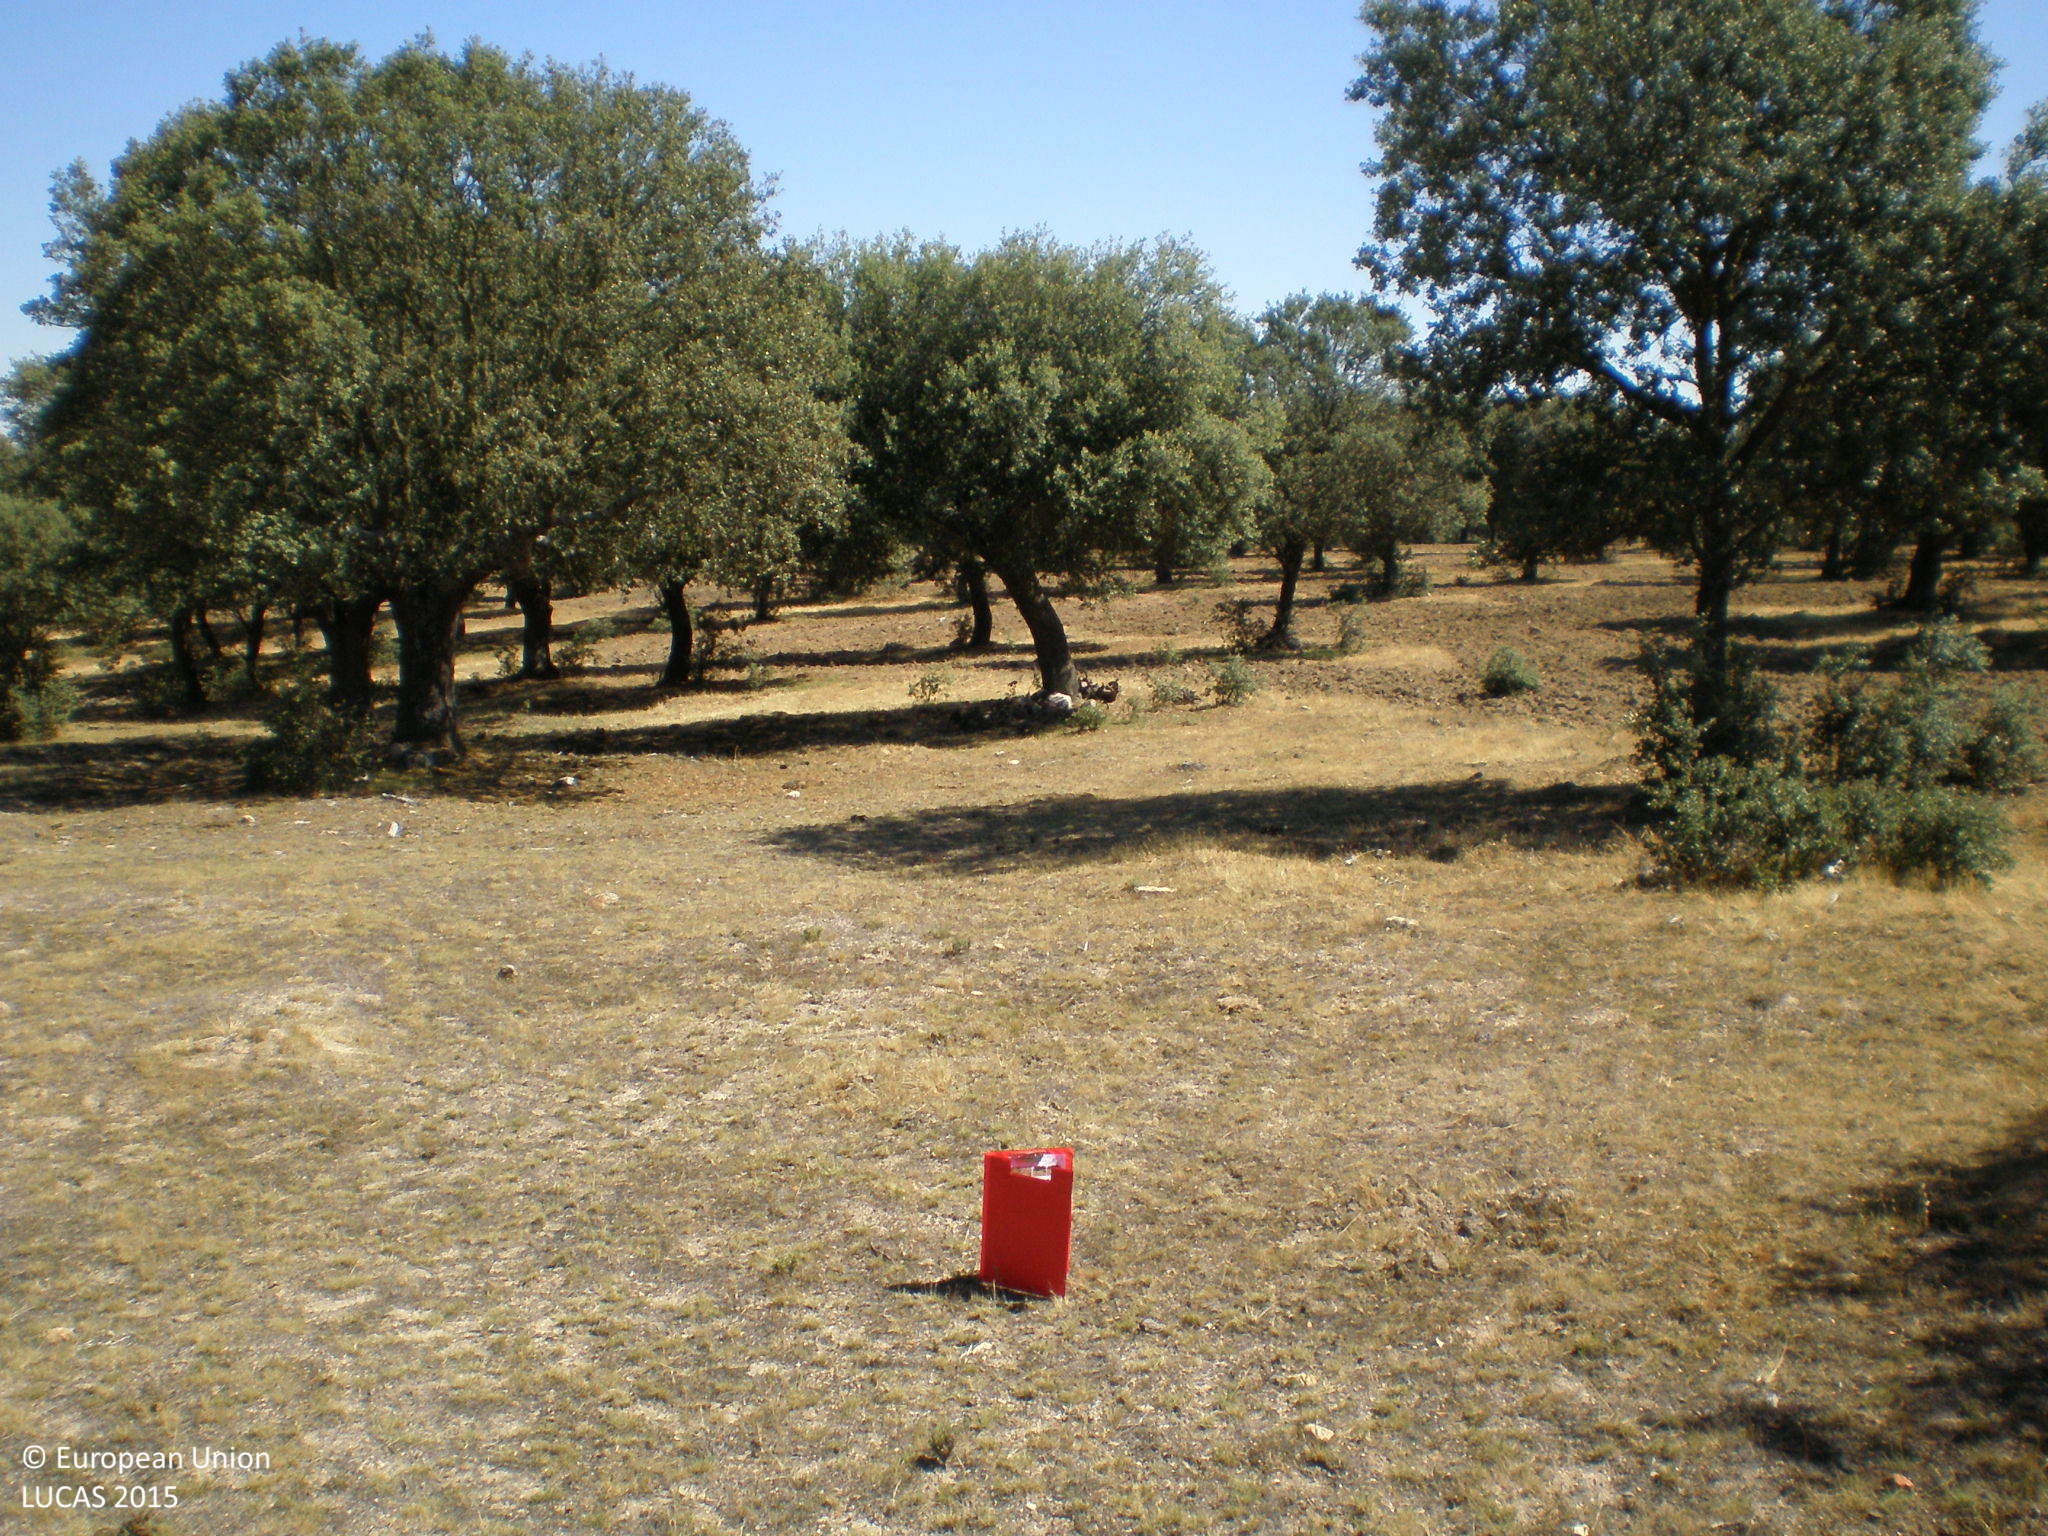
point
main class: Woodland
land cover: Broadleaved woodland
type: broadleaved evergreen forest
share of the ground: 25 - 50 %
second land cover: Grassland without tree/shrub cover
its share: 50 - 75 %
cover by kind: herbaceous plants 65 %, broadleaved forest trees 35 %
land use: Forestry
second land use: Agriculture (excluding fallow land and kitchen gardens)
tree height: > 5 m
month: June
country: ES
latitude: 40.8200
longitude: -5.6662
